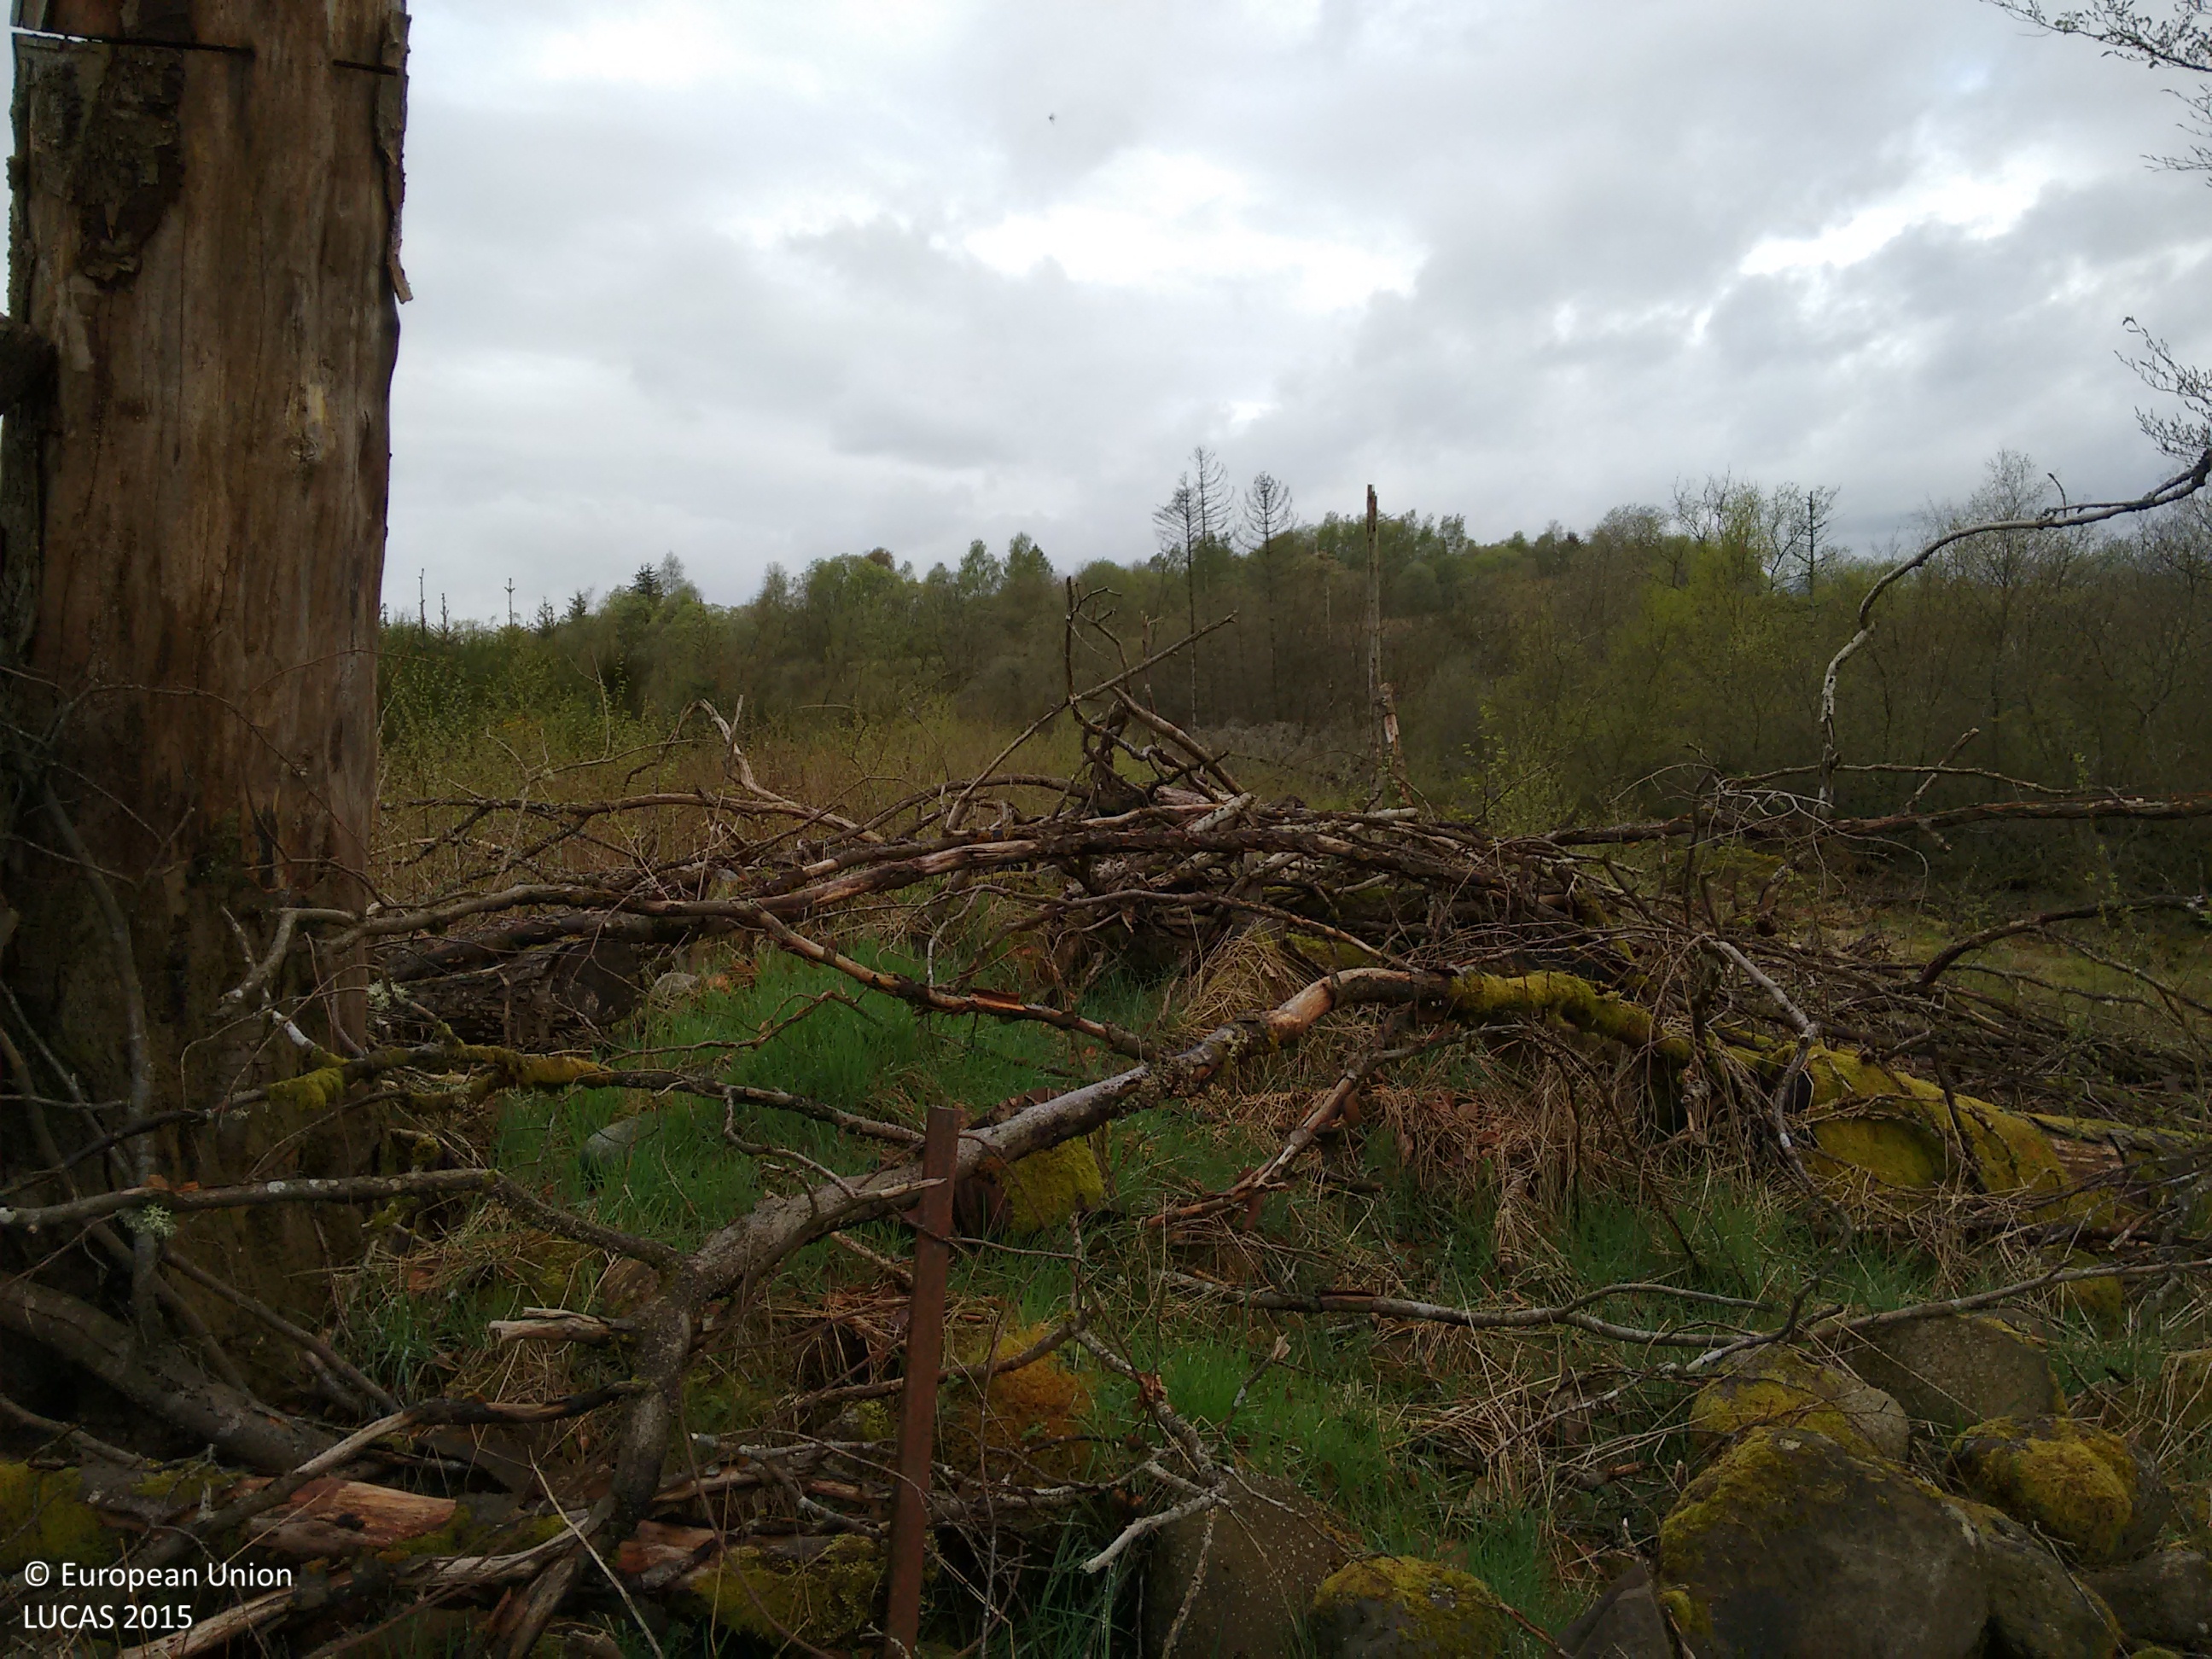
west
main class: Grassland
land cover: Grassland without tree/shrub cover
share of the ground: > 75 %
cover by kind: herbaceous plants 100 %
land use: Agriculture (excluding fallow land and kitchen gardens)
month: May
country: GB
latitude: 56.2086
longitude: -4.0983
